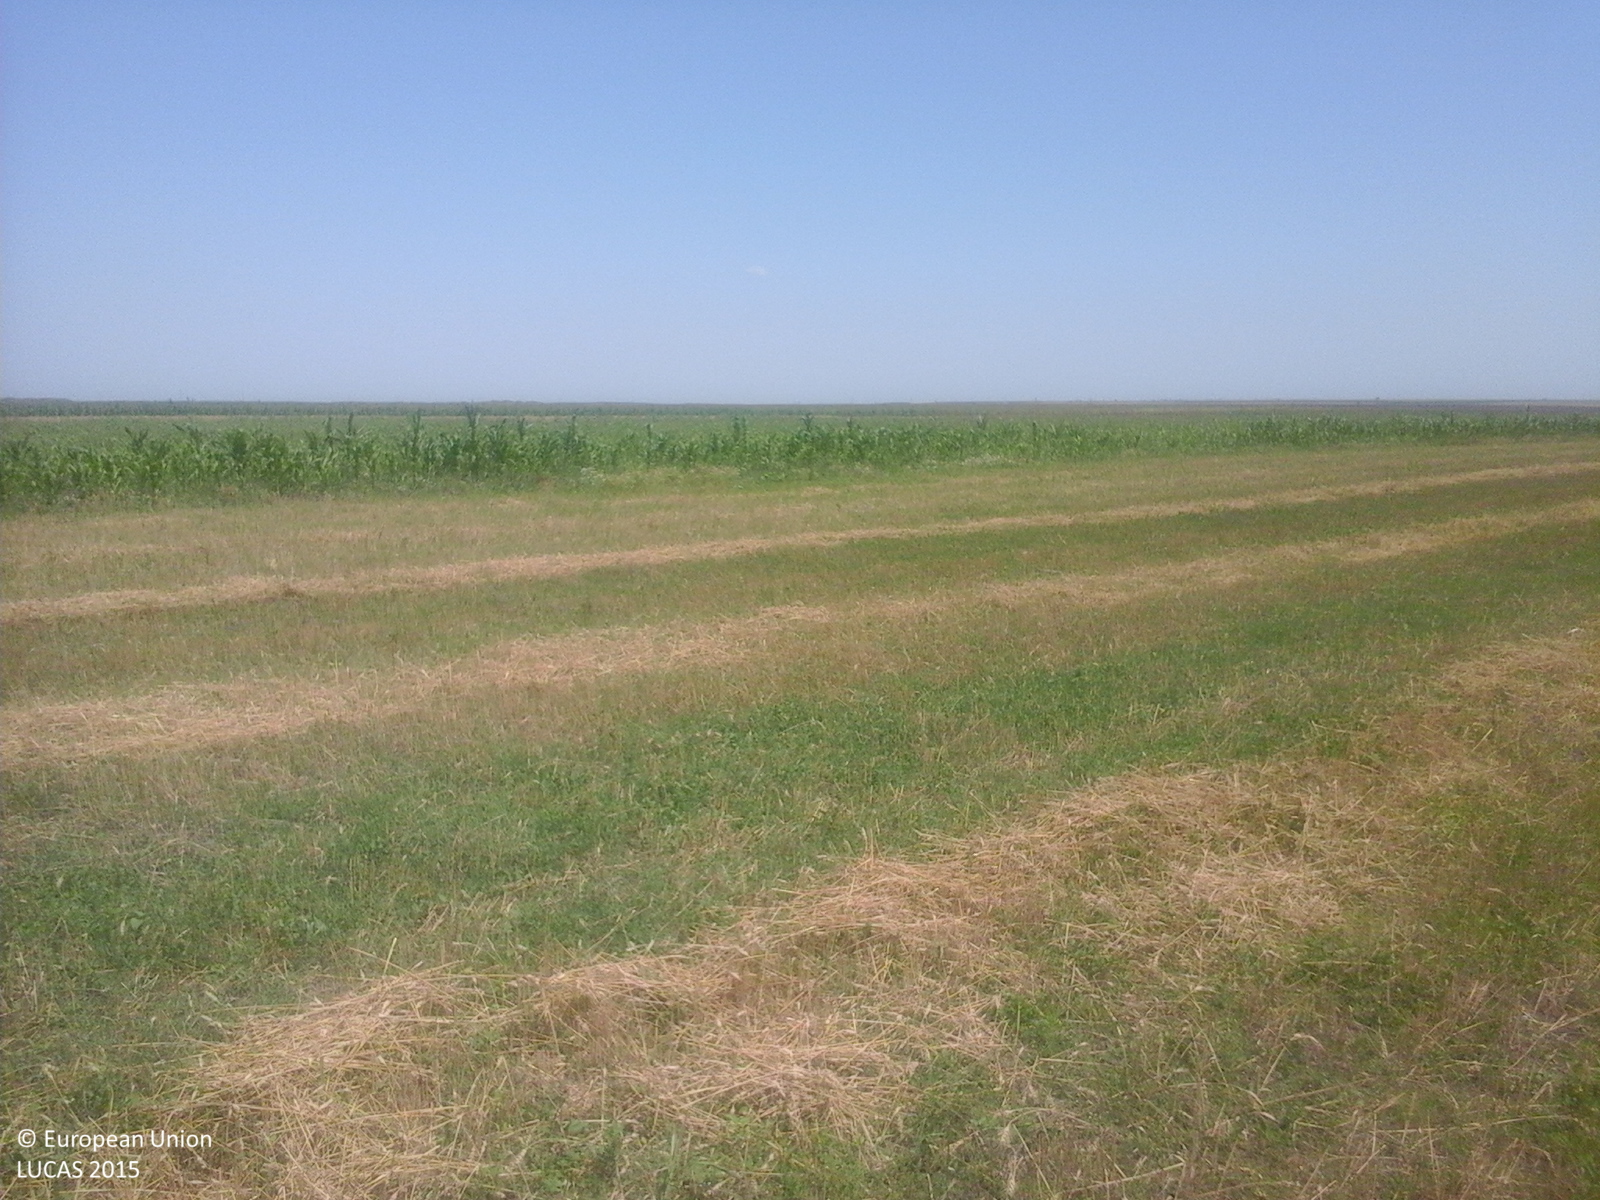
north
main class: Cropland
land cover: Sunflower
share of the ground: > 75 %
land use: Agriculture (excluding fallow land and kitchen gardens)
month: July
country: RO
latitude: 44.1943
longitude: 24.6984
